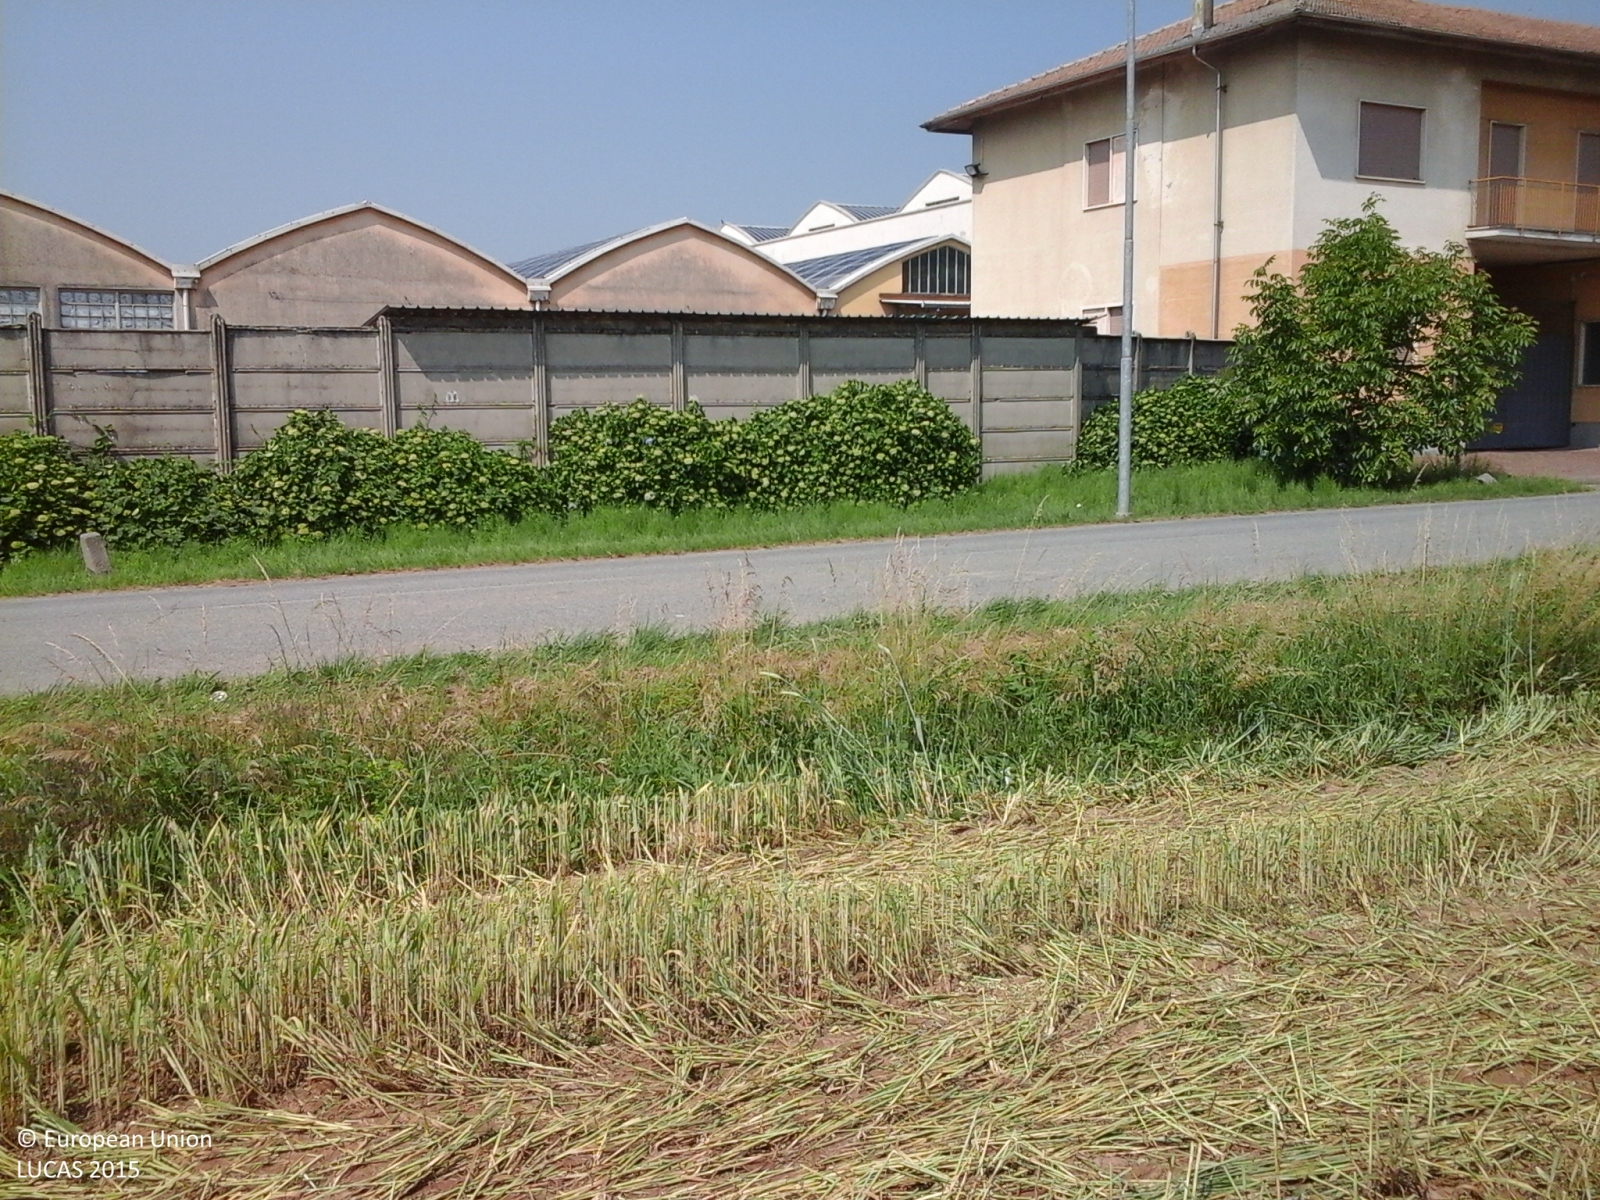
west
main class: Cropland
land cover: Mixed cereals for fodder
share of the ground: > 75 %
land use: Agriculture (excluding fallow land and kitchen gardens)
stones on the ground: 10 - 25 %
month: June
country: IT
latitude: 45.4692
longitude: 8.0973
